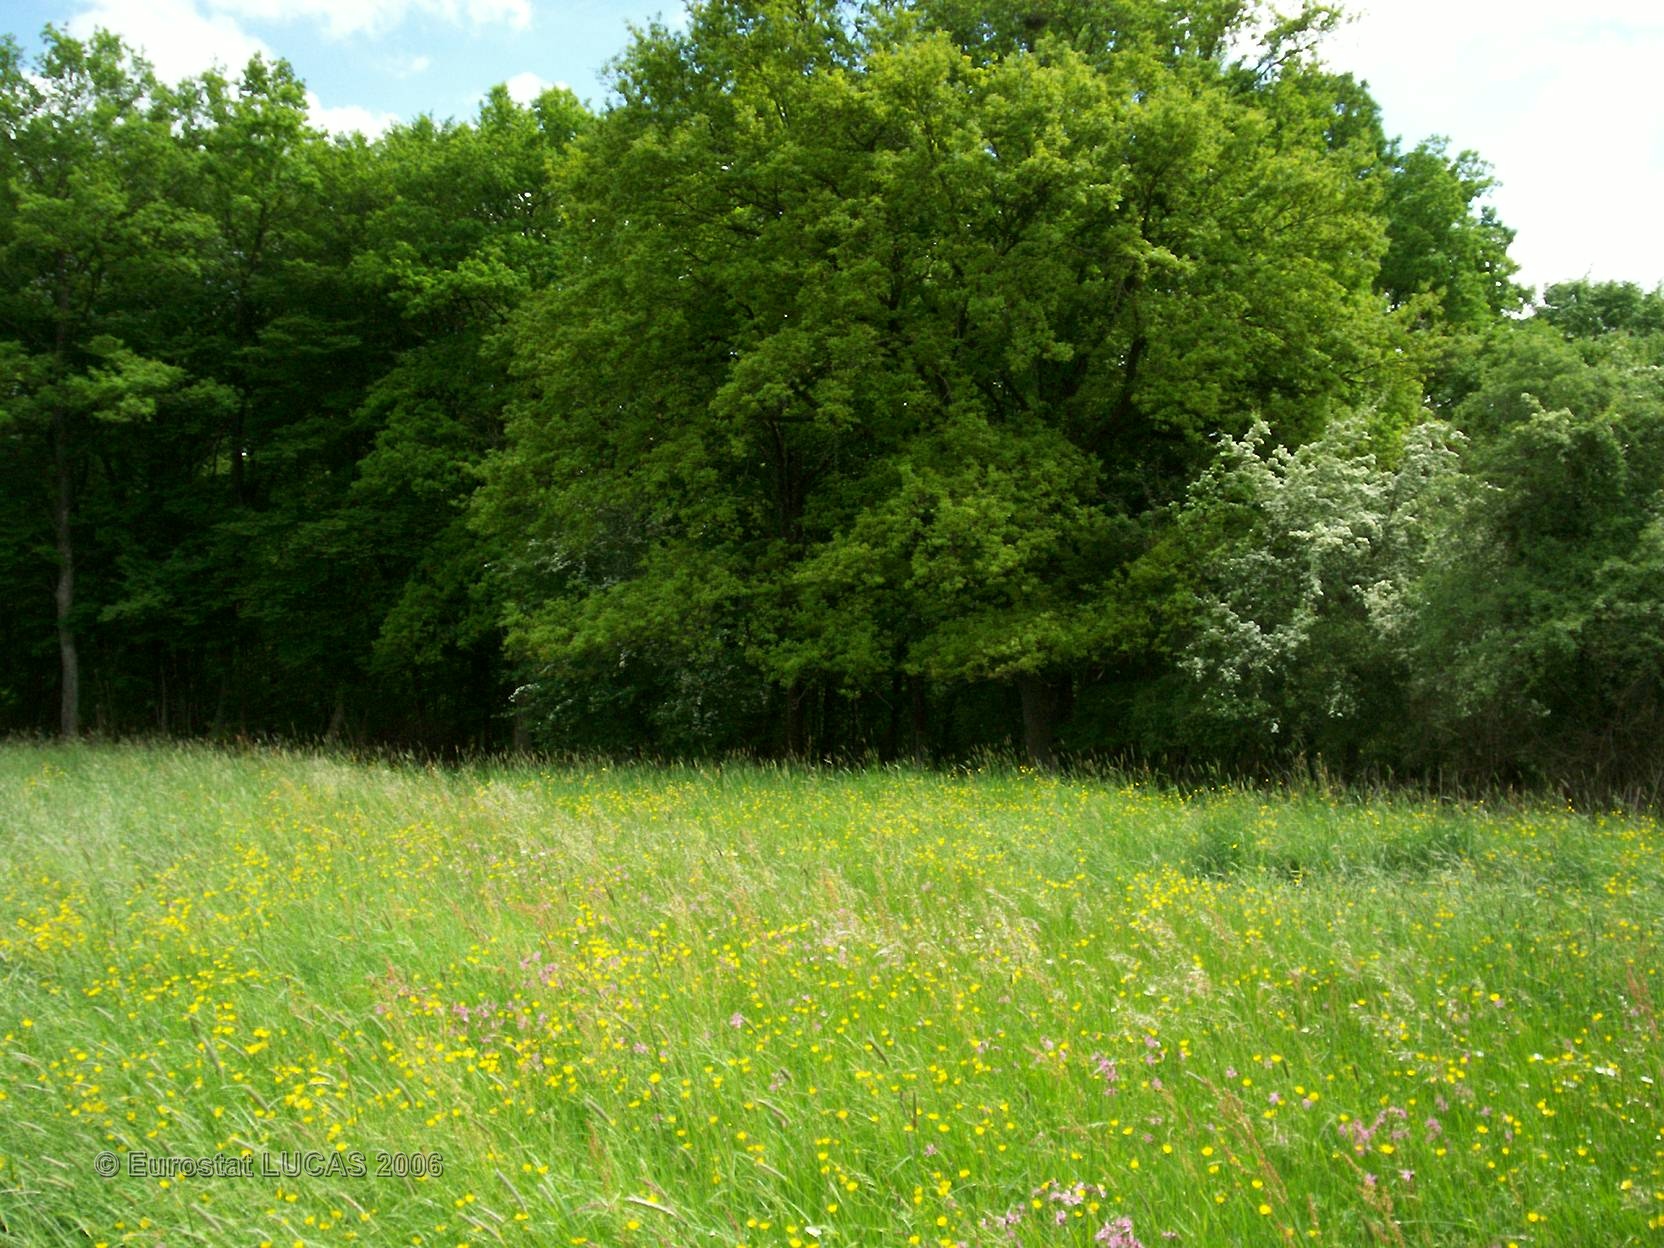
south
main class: Grassland
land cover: Grassland without tree/shrub cover
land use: Agriculture (excluding fallow land and kitchen gardens)
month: May
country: FR
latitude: 48.6089
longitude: 6.7862
